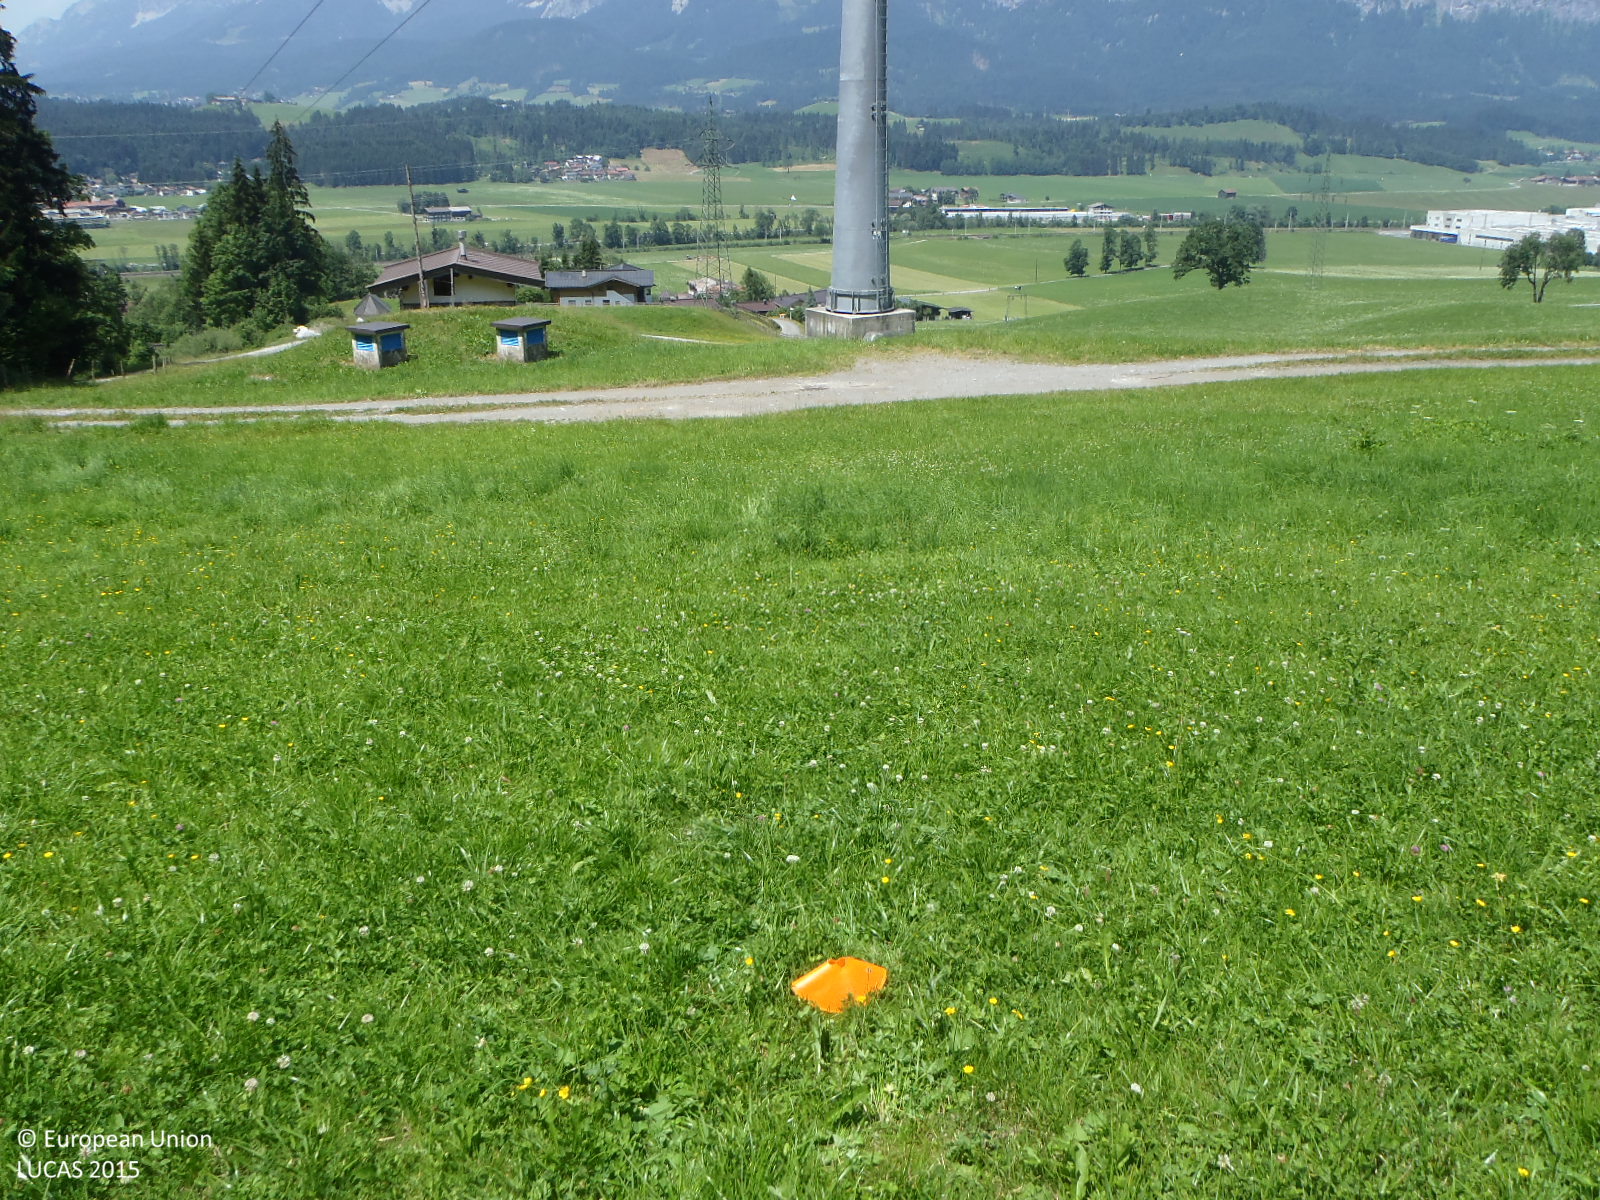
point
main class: Grassland
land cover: Grassland without tree/shrub cover
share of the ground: > 75 %
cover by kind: herbaceous plants 100 %
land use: Agriculture (excluding fallow land and kitchen gardens)
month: July
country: AT
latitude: 47.4952
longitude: 12.4009
